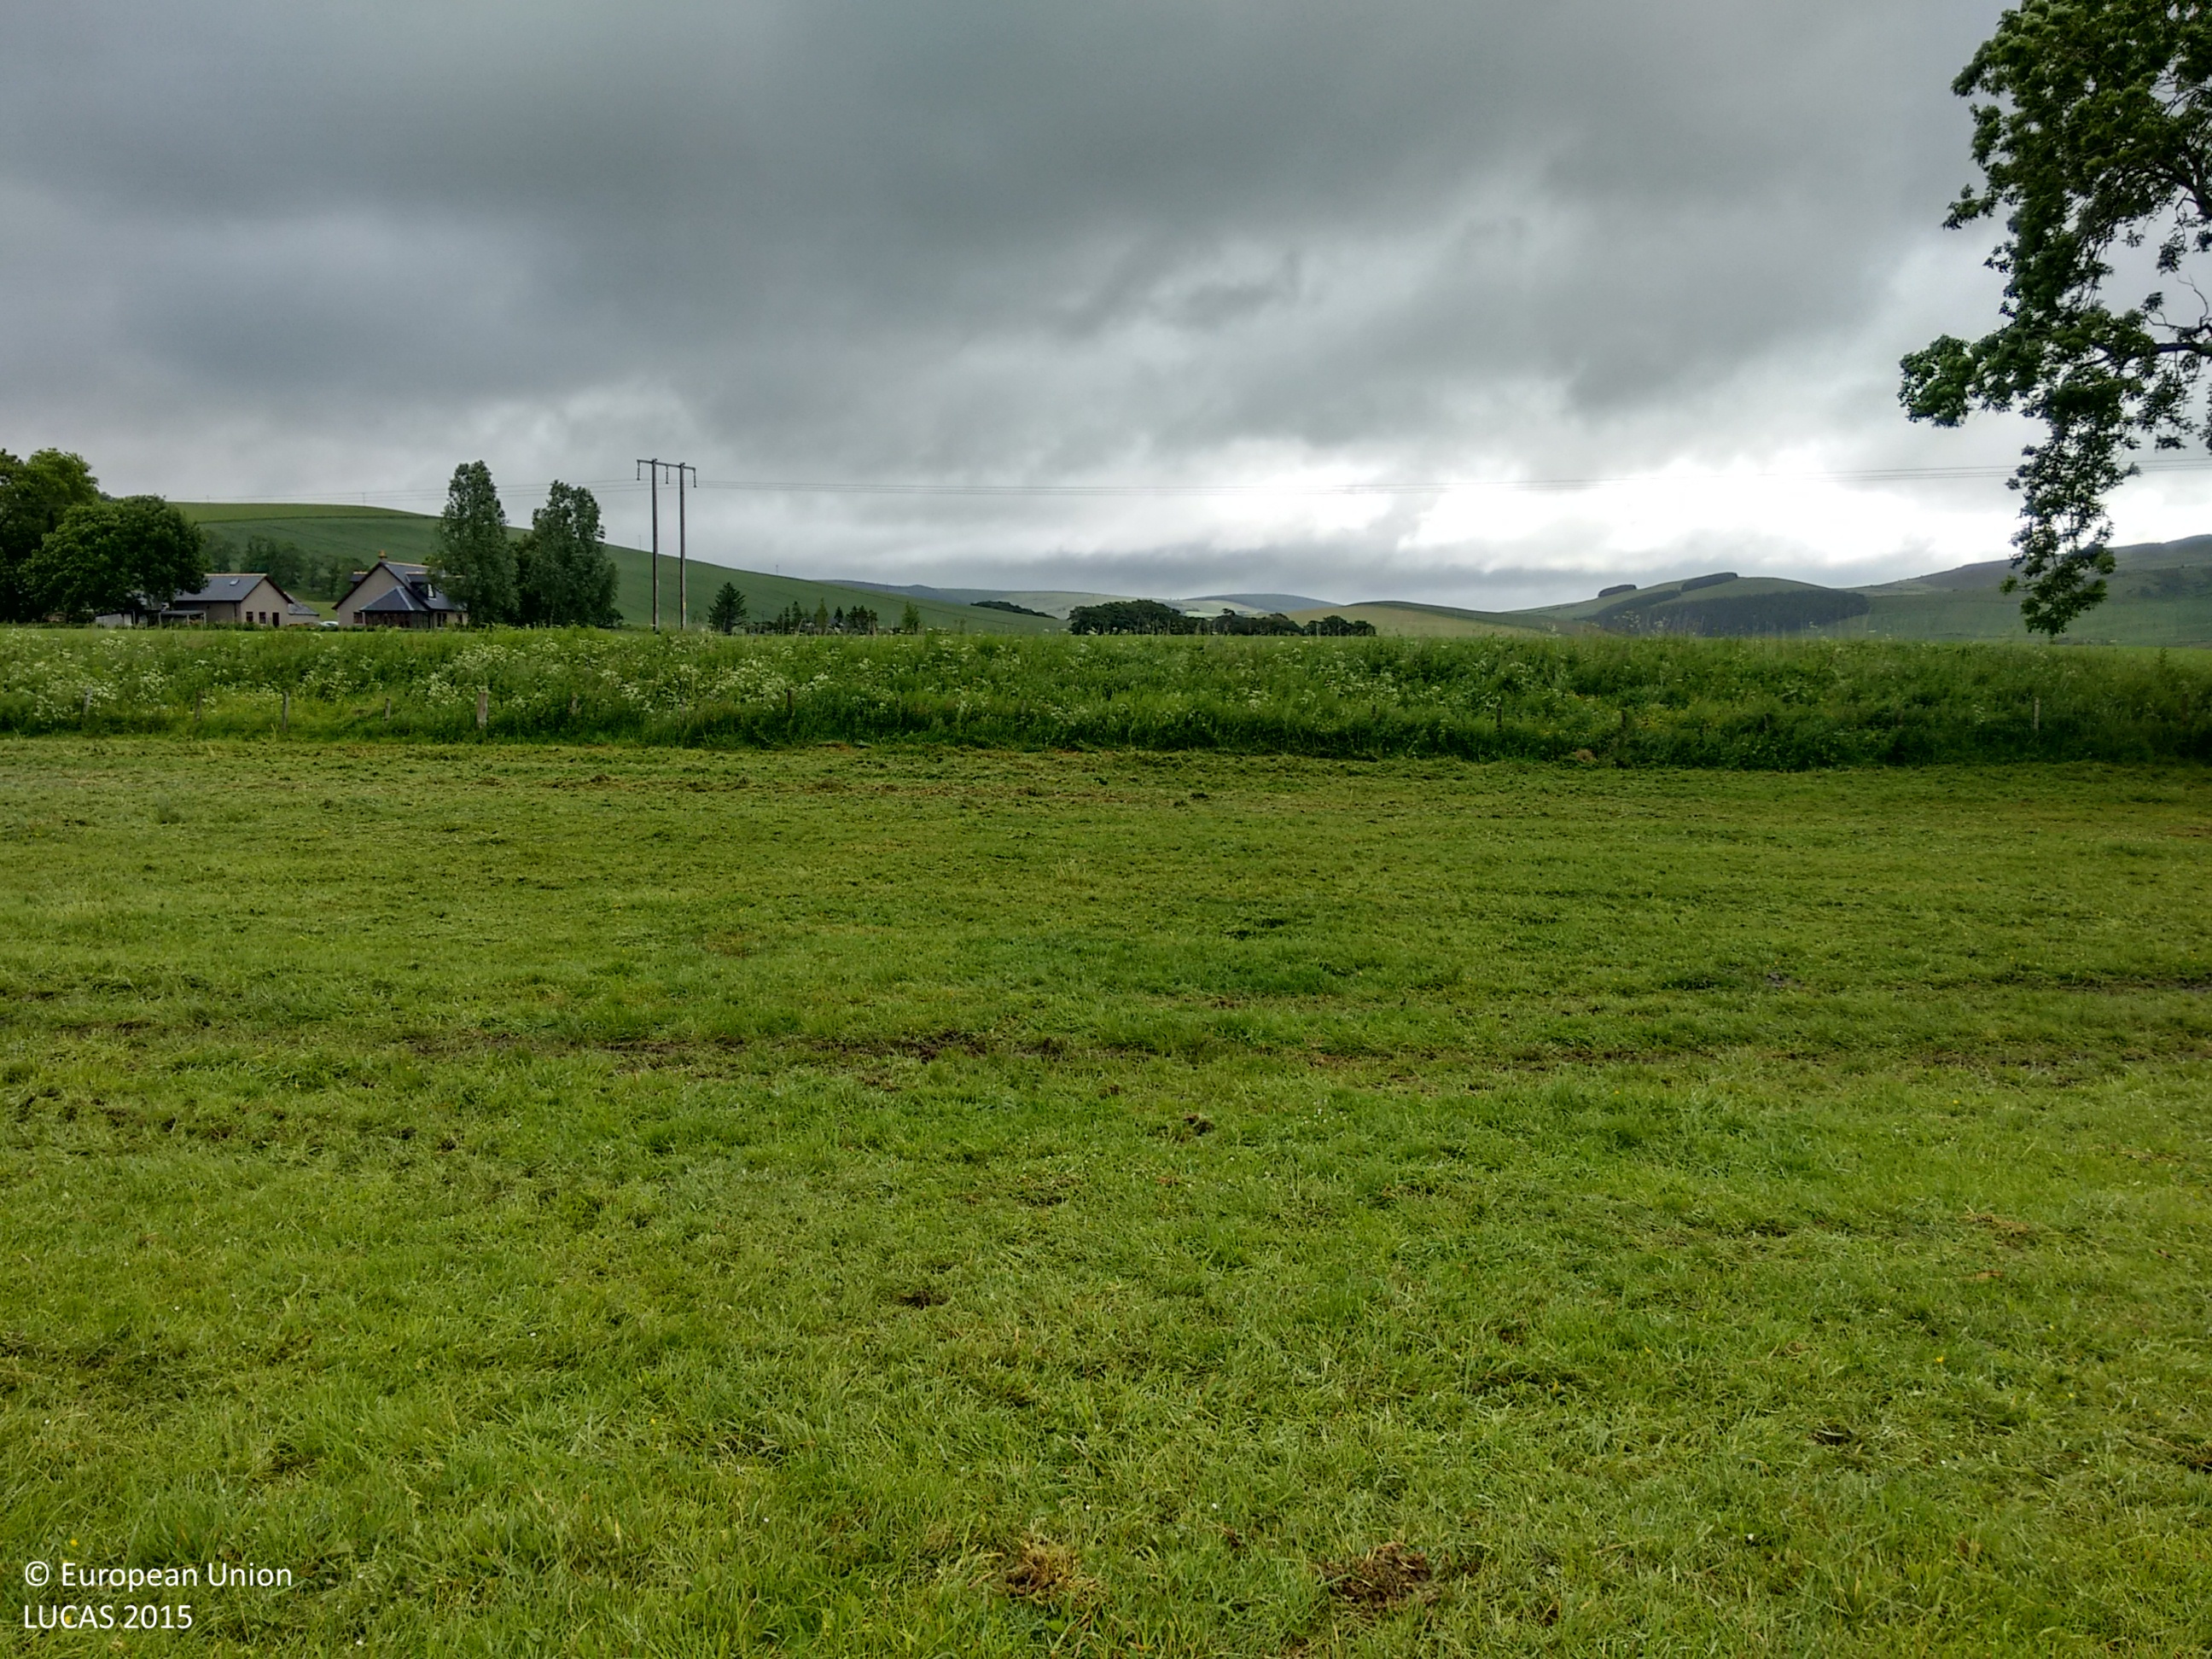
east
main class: Grassland
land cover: Grassland without tree/shrub cover
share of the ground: > 75 %
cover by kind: herbaceous plants 100 %
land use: Agriculture (excluding fallow land and kitchen gardens)
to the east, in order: Grassland without tree/shrub cover; Fences; Lines of trees; Temporary grasslands; Electric lines; Grass margins; Fences; Grass margins; Ditches and canals; Grass margins; Fences; Grassland without tree/shrub cover
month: July
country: GB
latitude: 57.2087
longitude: -2.9249
